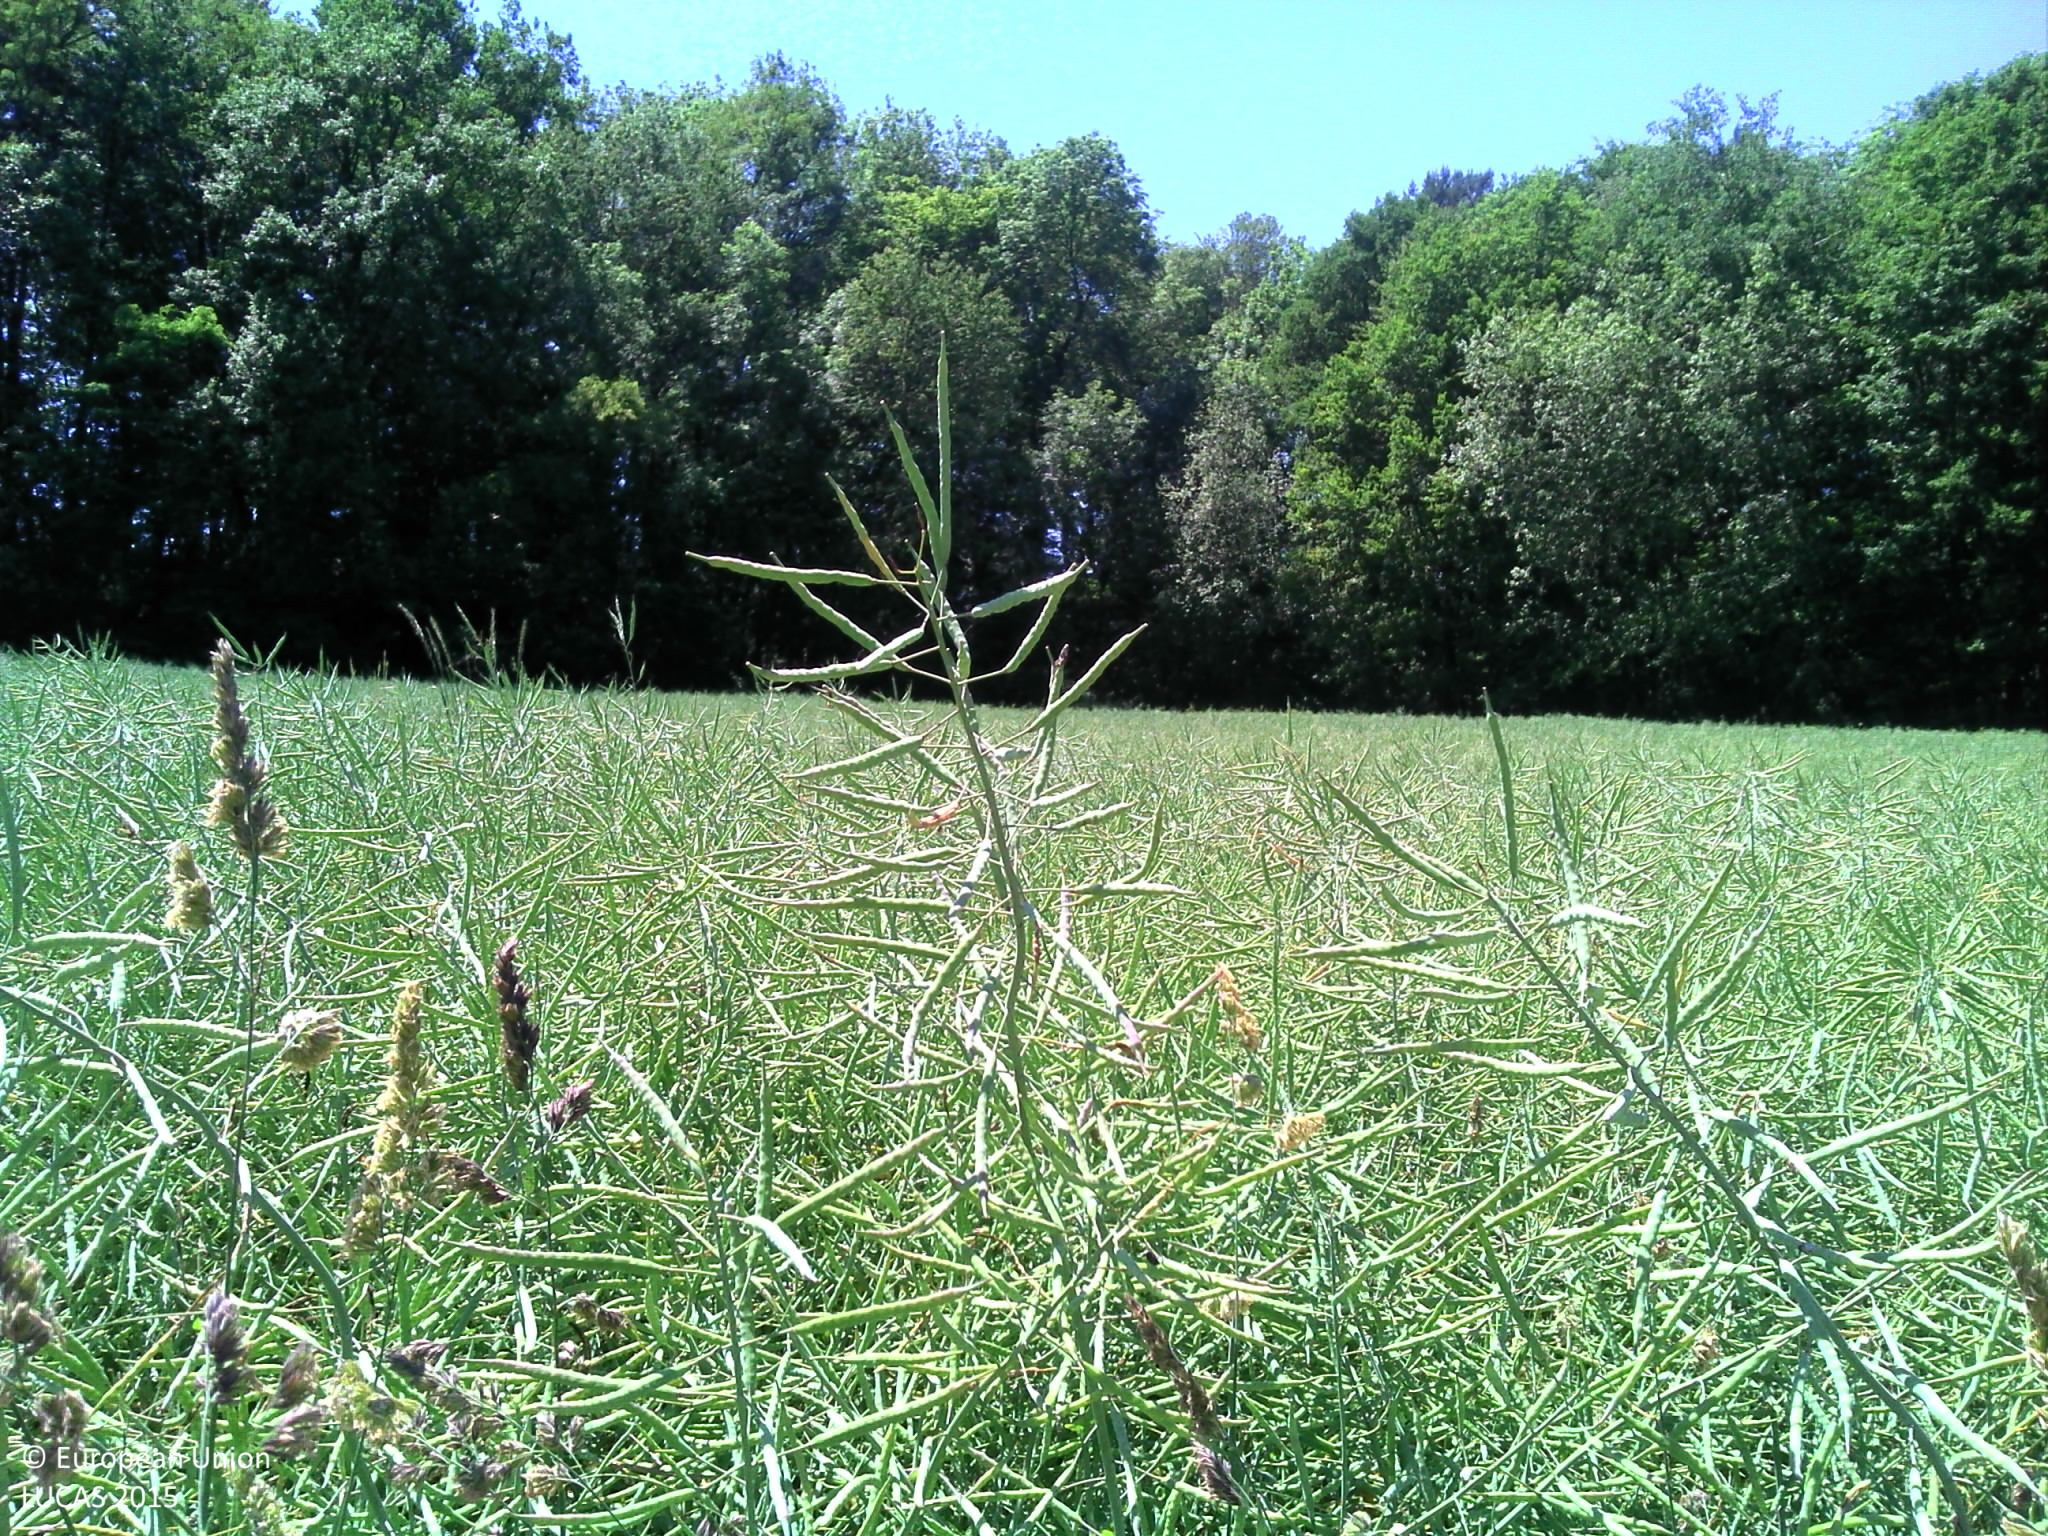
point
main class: Cropland
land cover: Rape and turnip rape
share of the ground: > 75 %
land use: Agriculture (excluding fallow land and kitchen gardens)
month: June
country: FR
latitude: 47.5394
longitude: 6.0290
